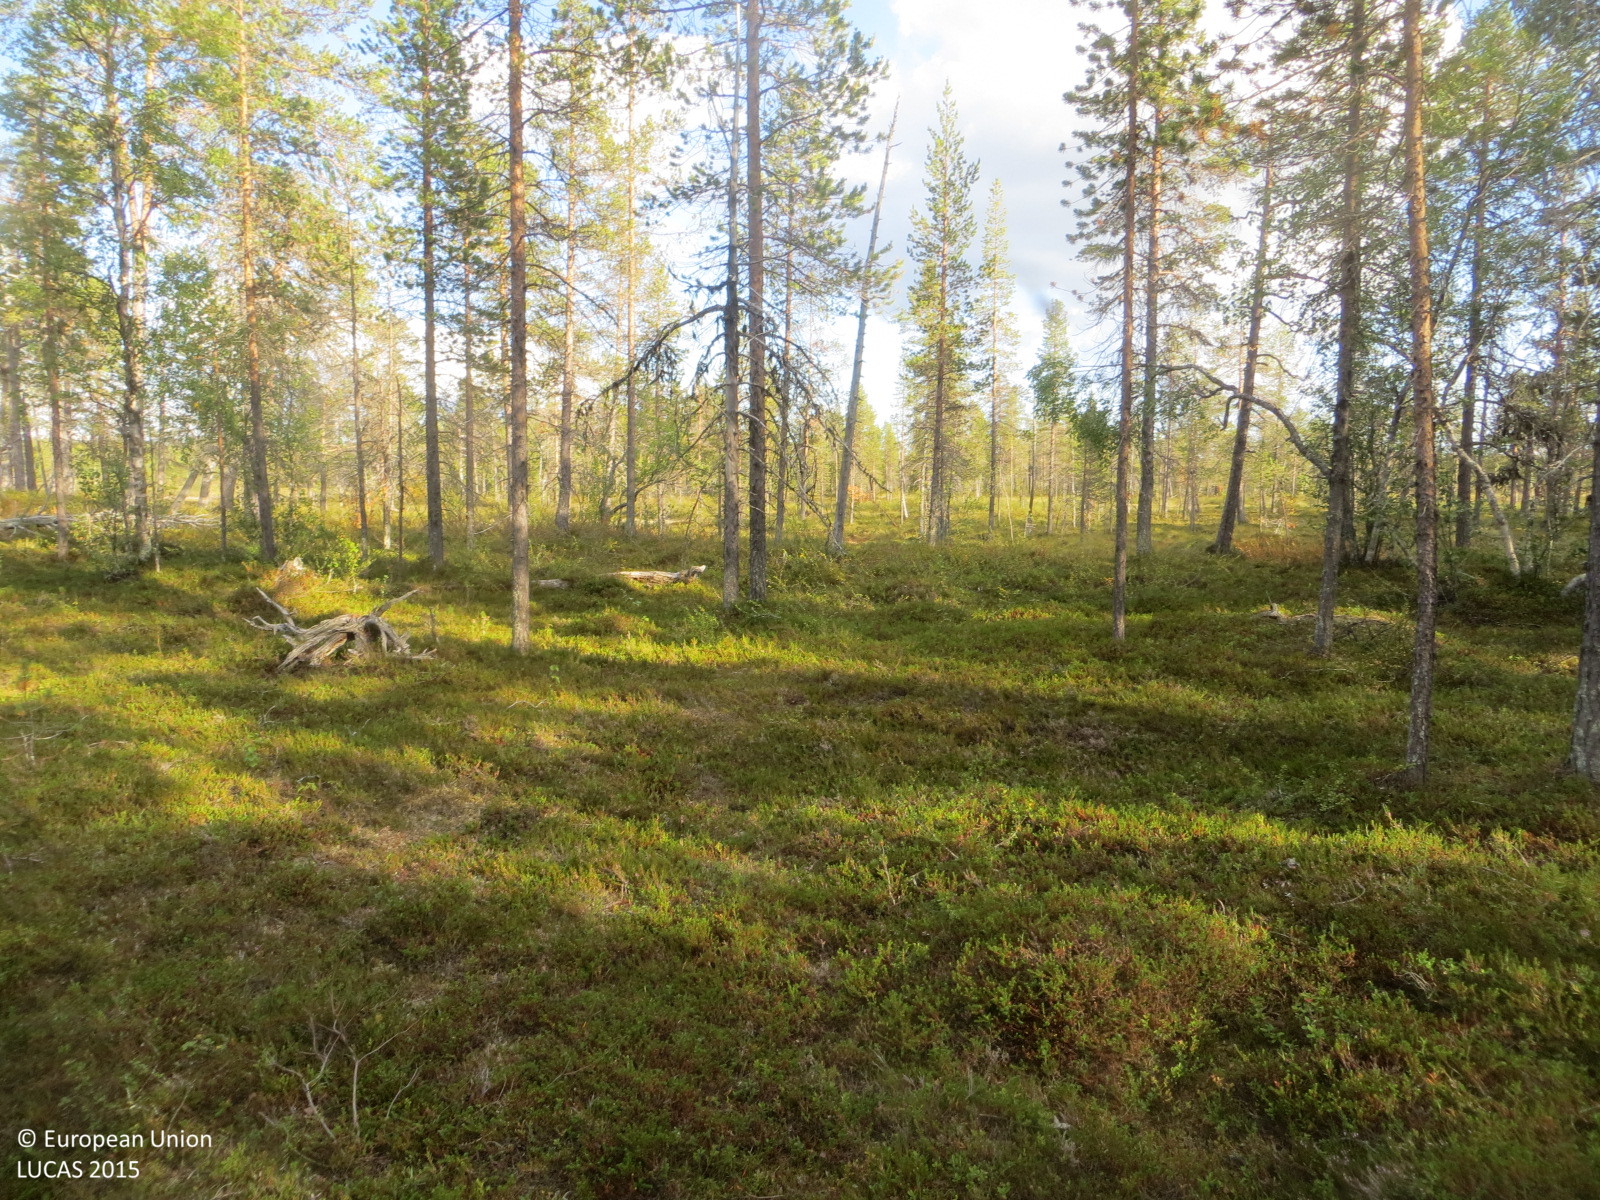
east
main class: Woodland
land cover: Pine dominated coniferous woodland
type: boreal forest
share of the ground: 50 - 75 %
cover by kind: shrubs 50 %, coniferous forest trees 45 %, broadleaved forest trees 5 %
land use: Forestry
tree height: > 5 m
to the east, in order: Pine dominated coniferous woodland; Pine dominated mixed woodland; Shrubland with sparse tree cover; Peatbogs
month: August
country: FI
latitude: 68.2123
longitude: 25.6610
